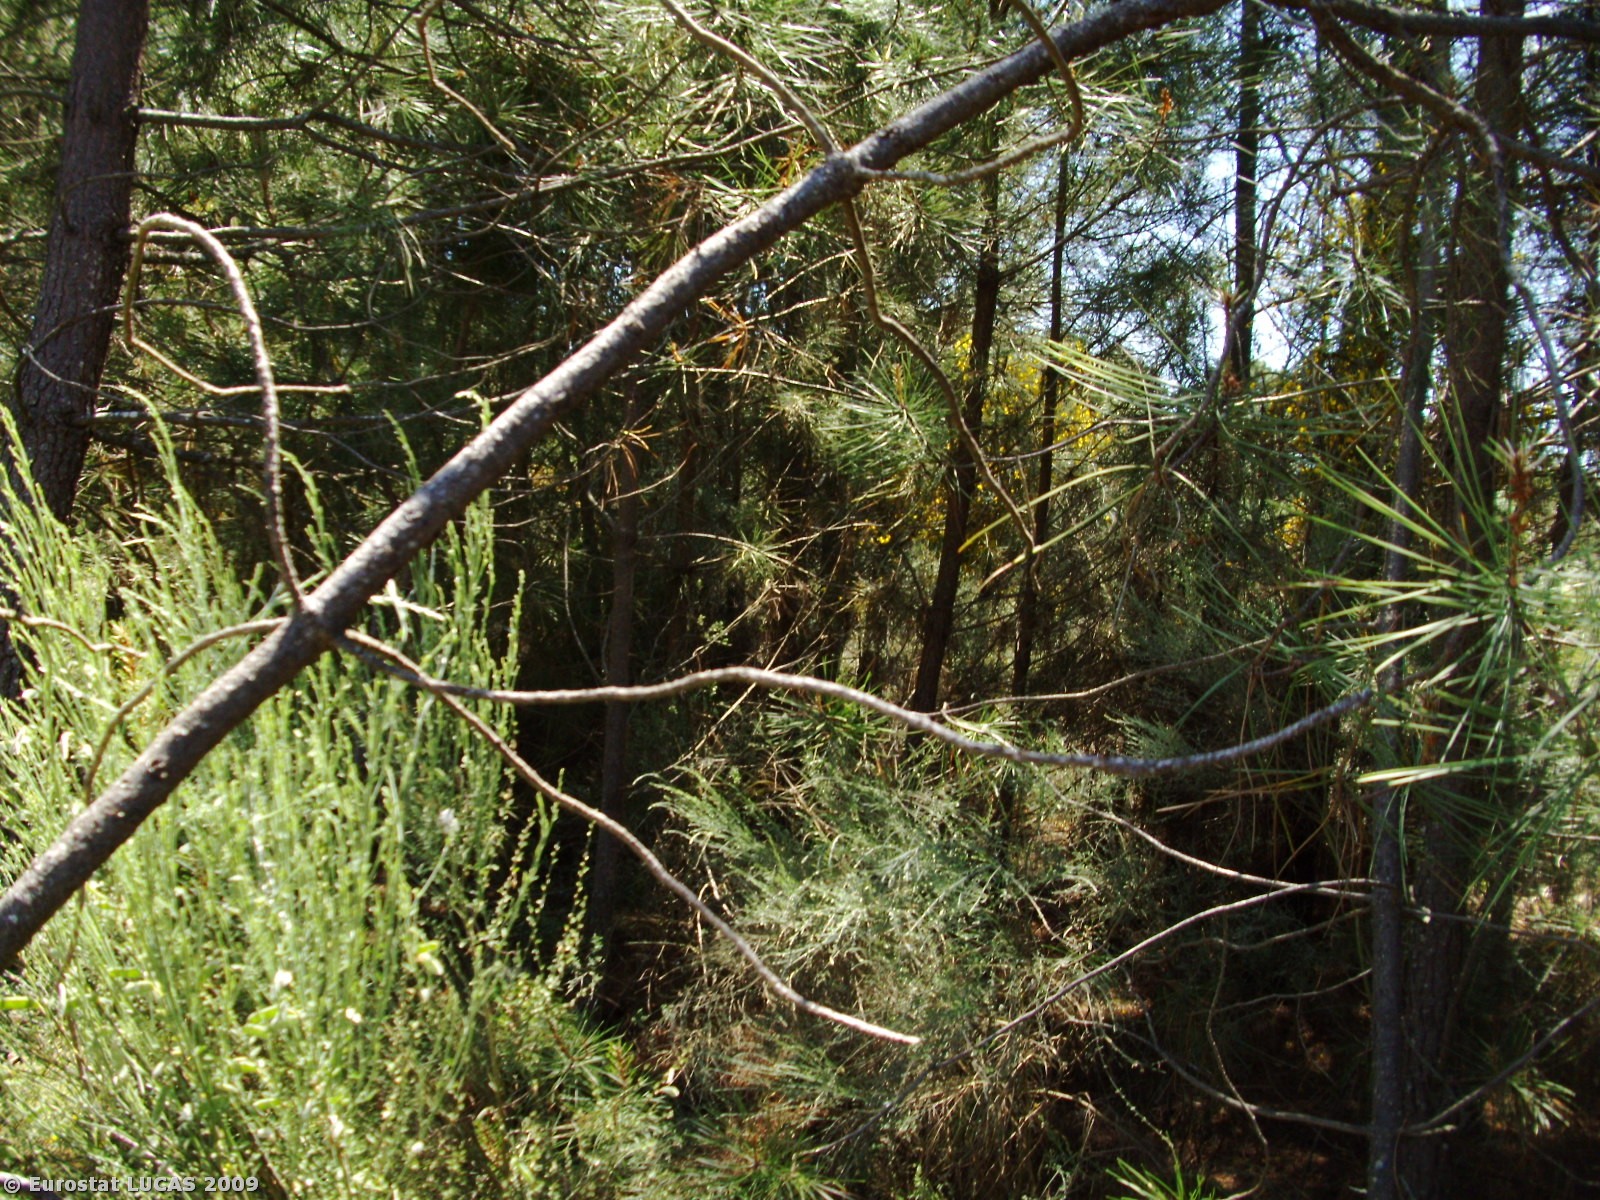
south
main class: Woodland
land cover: Coniferous woodland
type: coniferous forest of the mediterranean region
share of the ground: 10 - 25 %
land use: Forestry
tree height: > 5 m
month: May
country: PT
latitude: 40.7453
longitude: -7.5128
